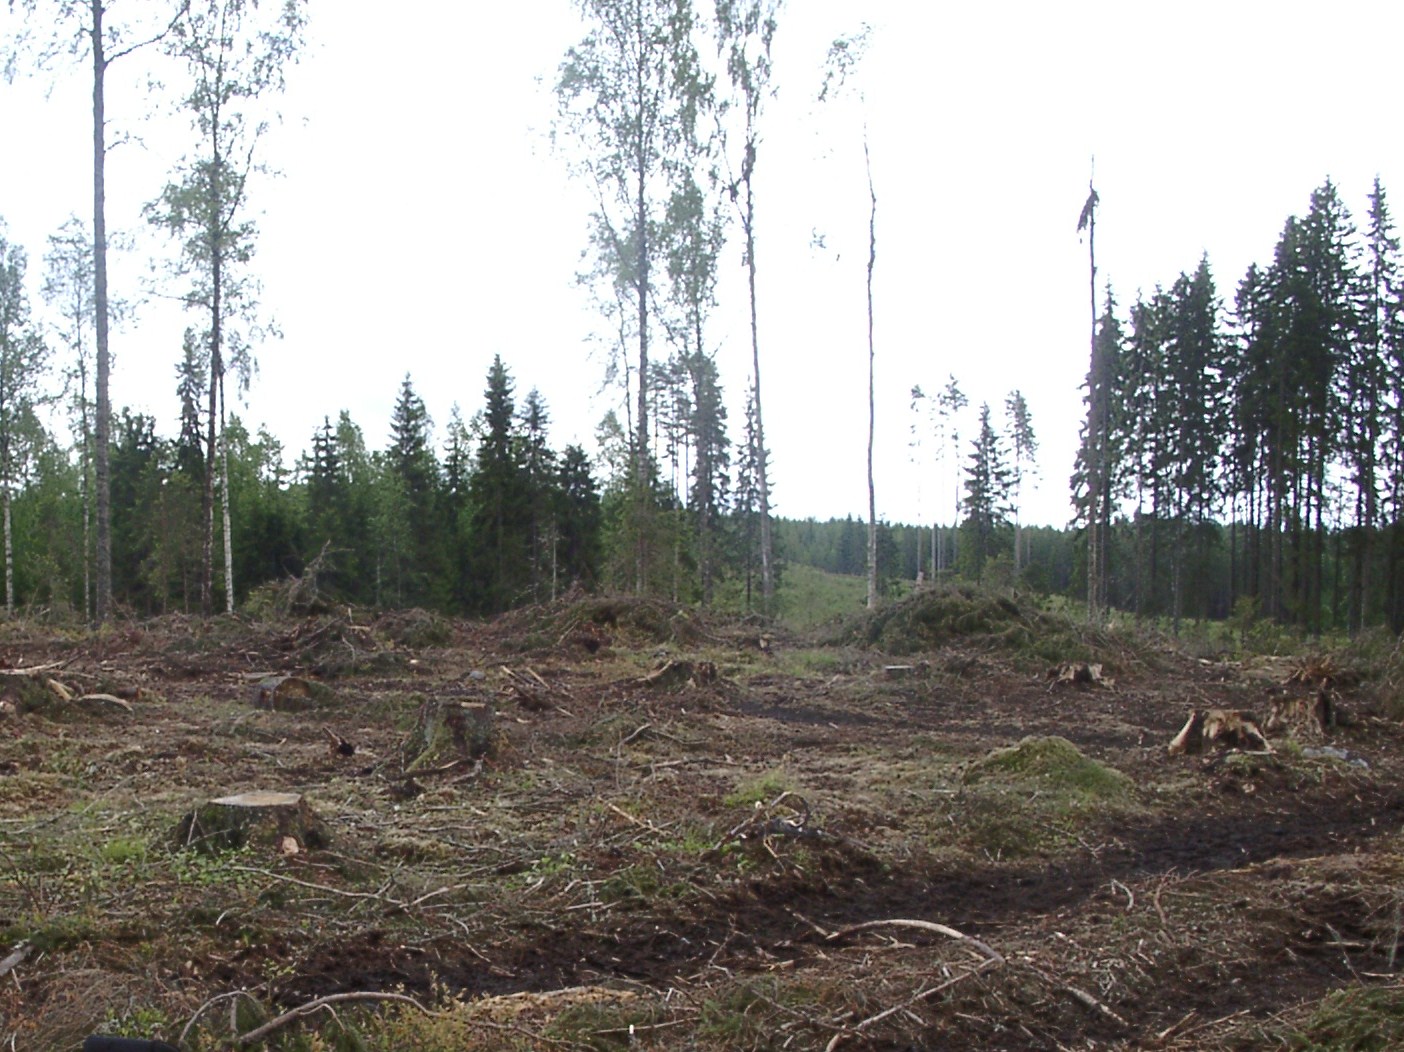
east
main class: Shrubland
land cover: Shrubland with sparse tree cover
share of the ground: 10 - 25 %
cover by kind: unconsolidated bare surface 50 %, shrubs 10 %, broadleaved forest trees 5 %
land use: Forestry
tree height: > 5 m
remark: Clear cut
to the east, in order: Shrubland with sparse tree cover; Ditches and canals; Shrubland with sparse tree cover; Spruce dominated mixed woodland
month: June
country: FI
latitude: 61.5792
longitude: 24.8144
